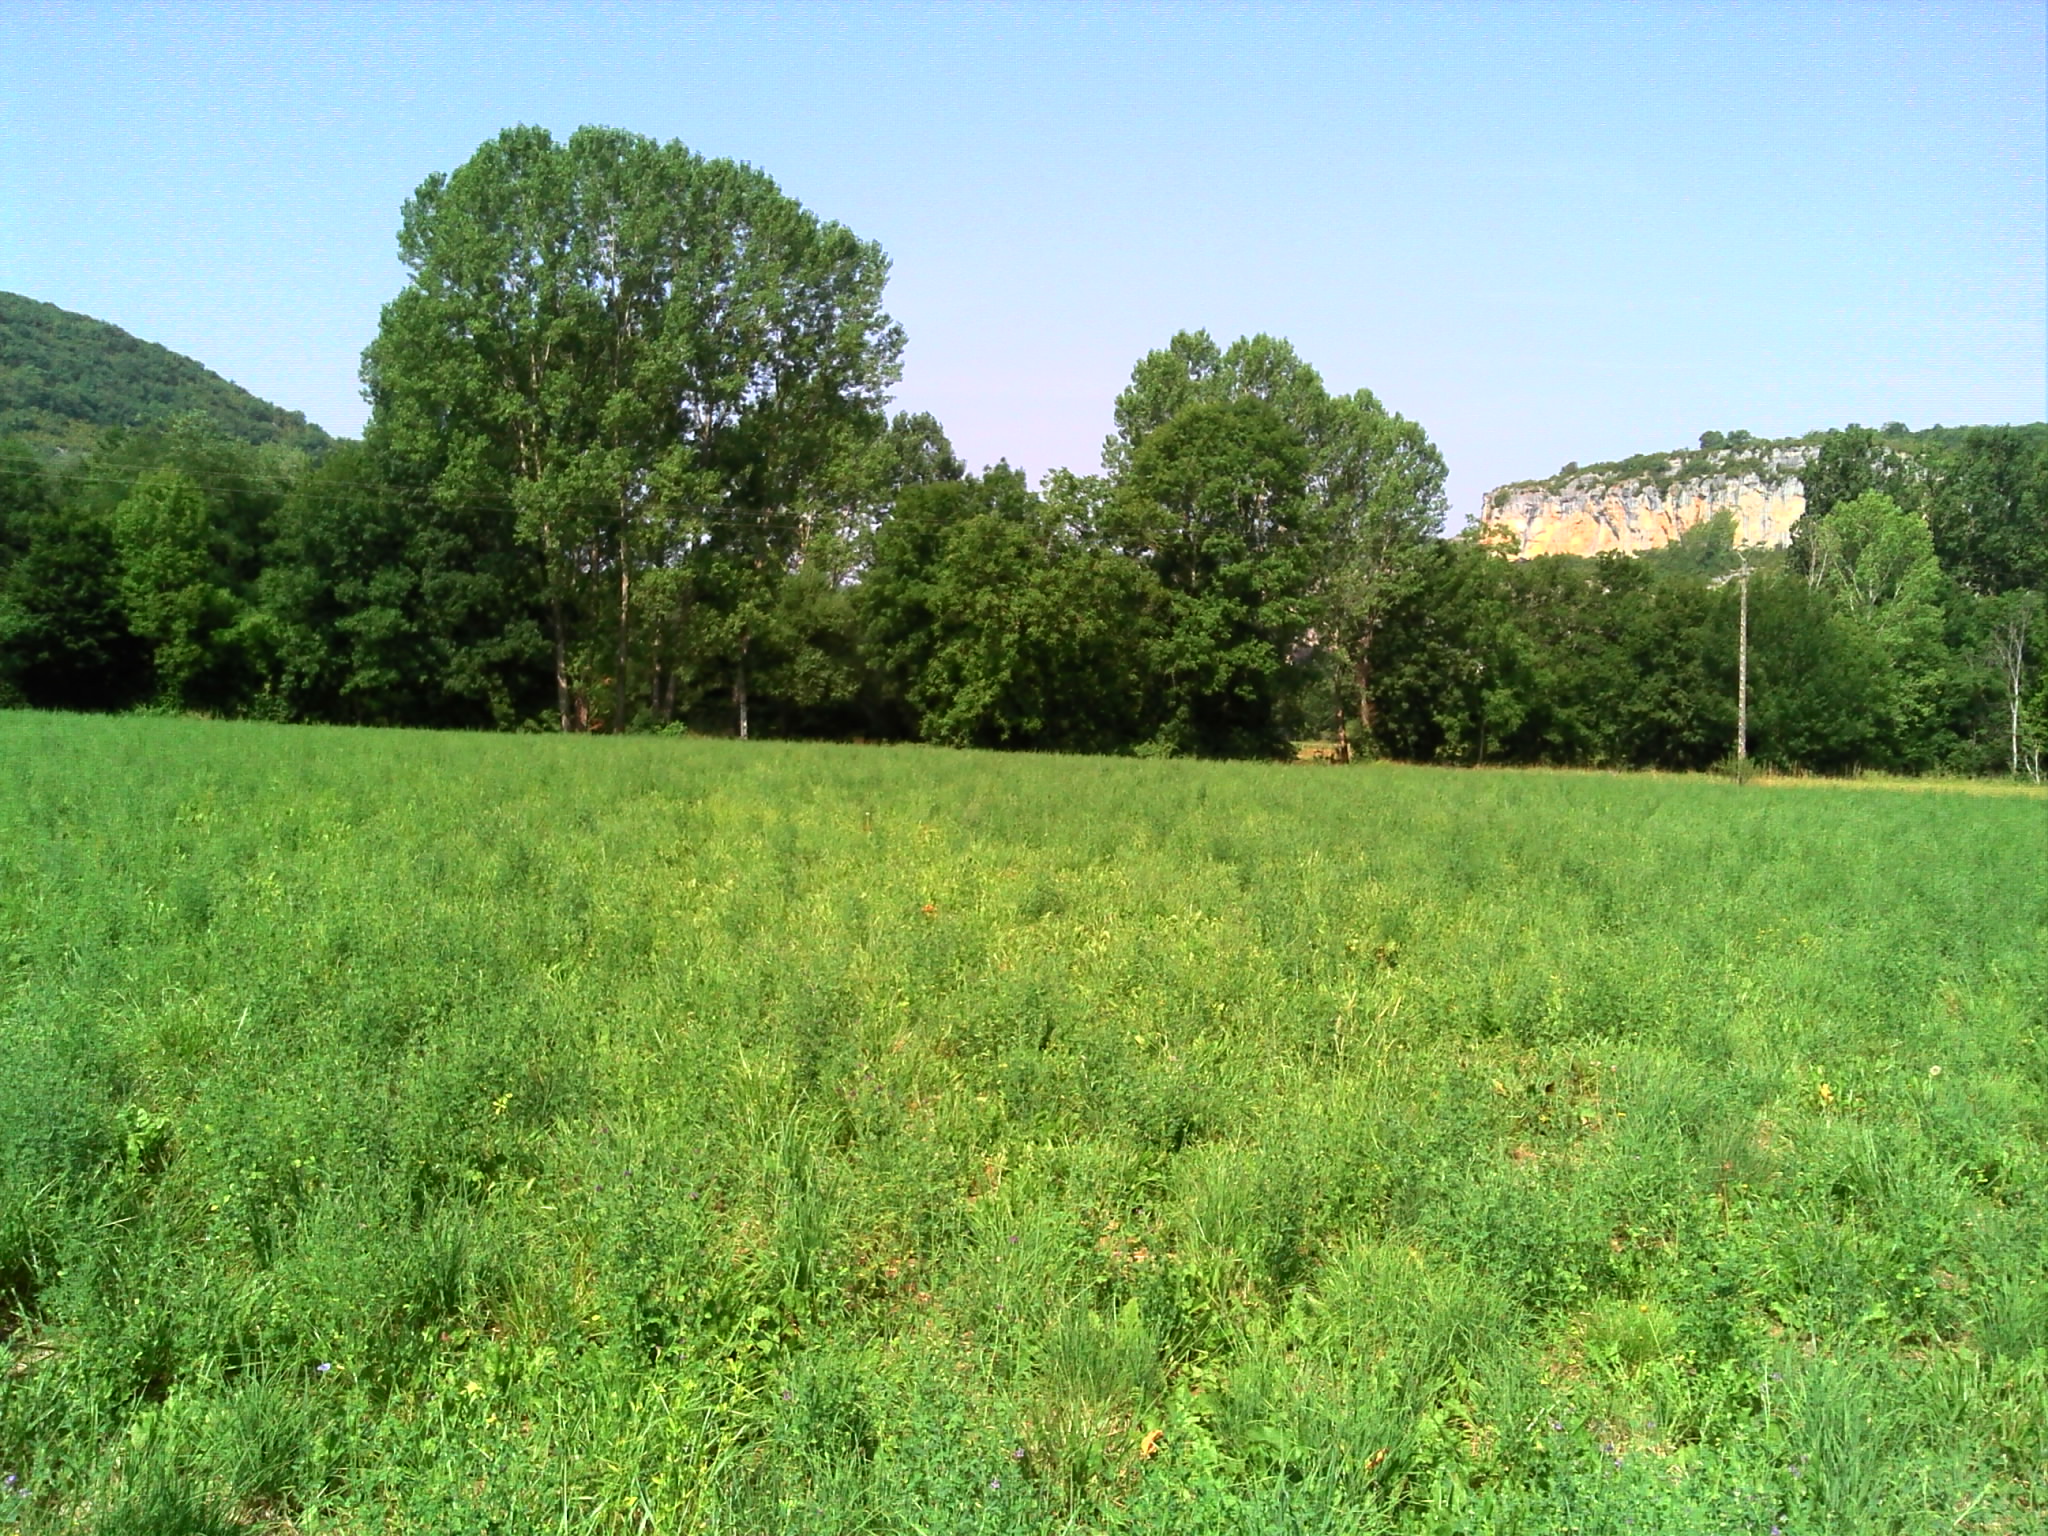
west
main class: Cropland
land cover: Lucerne
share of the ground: > 75 %
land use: Agriculture (excluding fallow land and kitchen gardens)
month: July
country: FR
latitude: 44.5694
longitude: 1.8020
